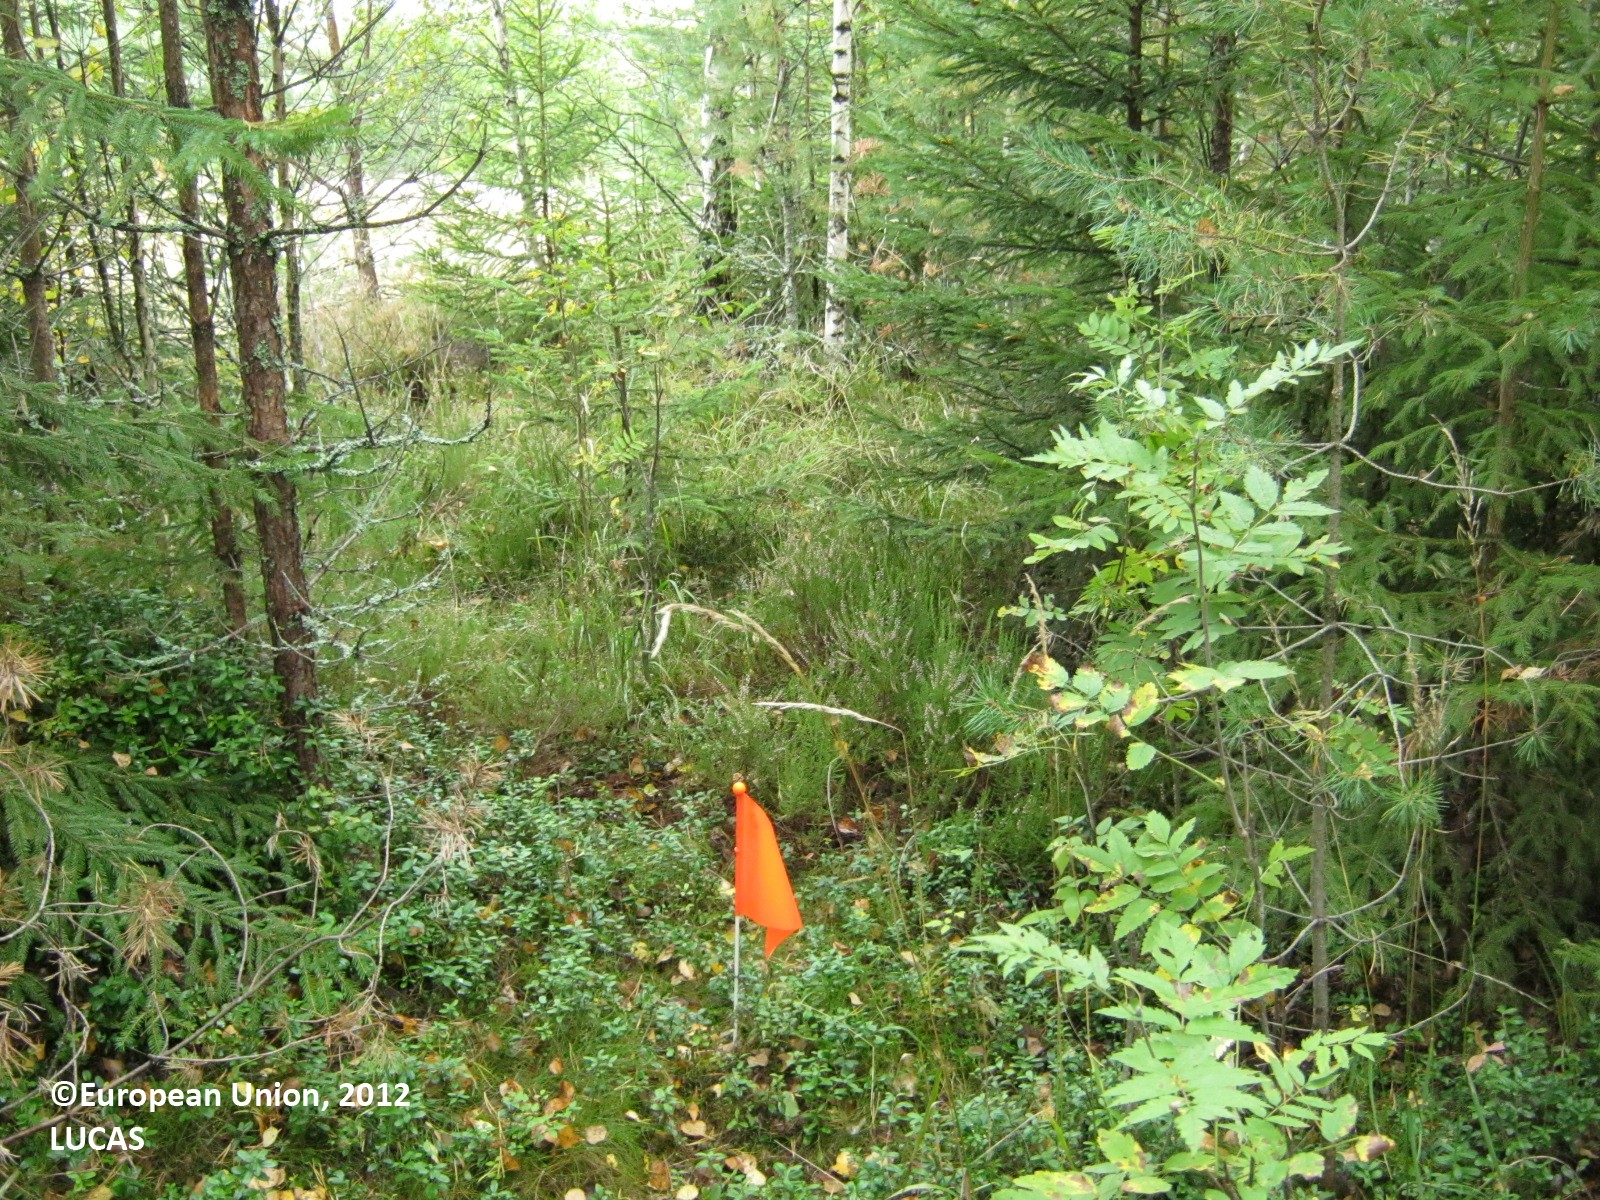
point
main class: Woodland
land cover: Spruce dominated mixed woodland
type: boreal forest
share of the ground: > 75 %
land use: Forestry
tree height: > 5 m
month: September
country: FI
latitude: 60.5716
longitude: 27.8032
